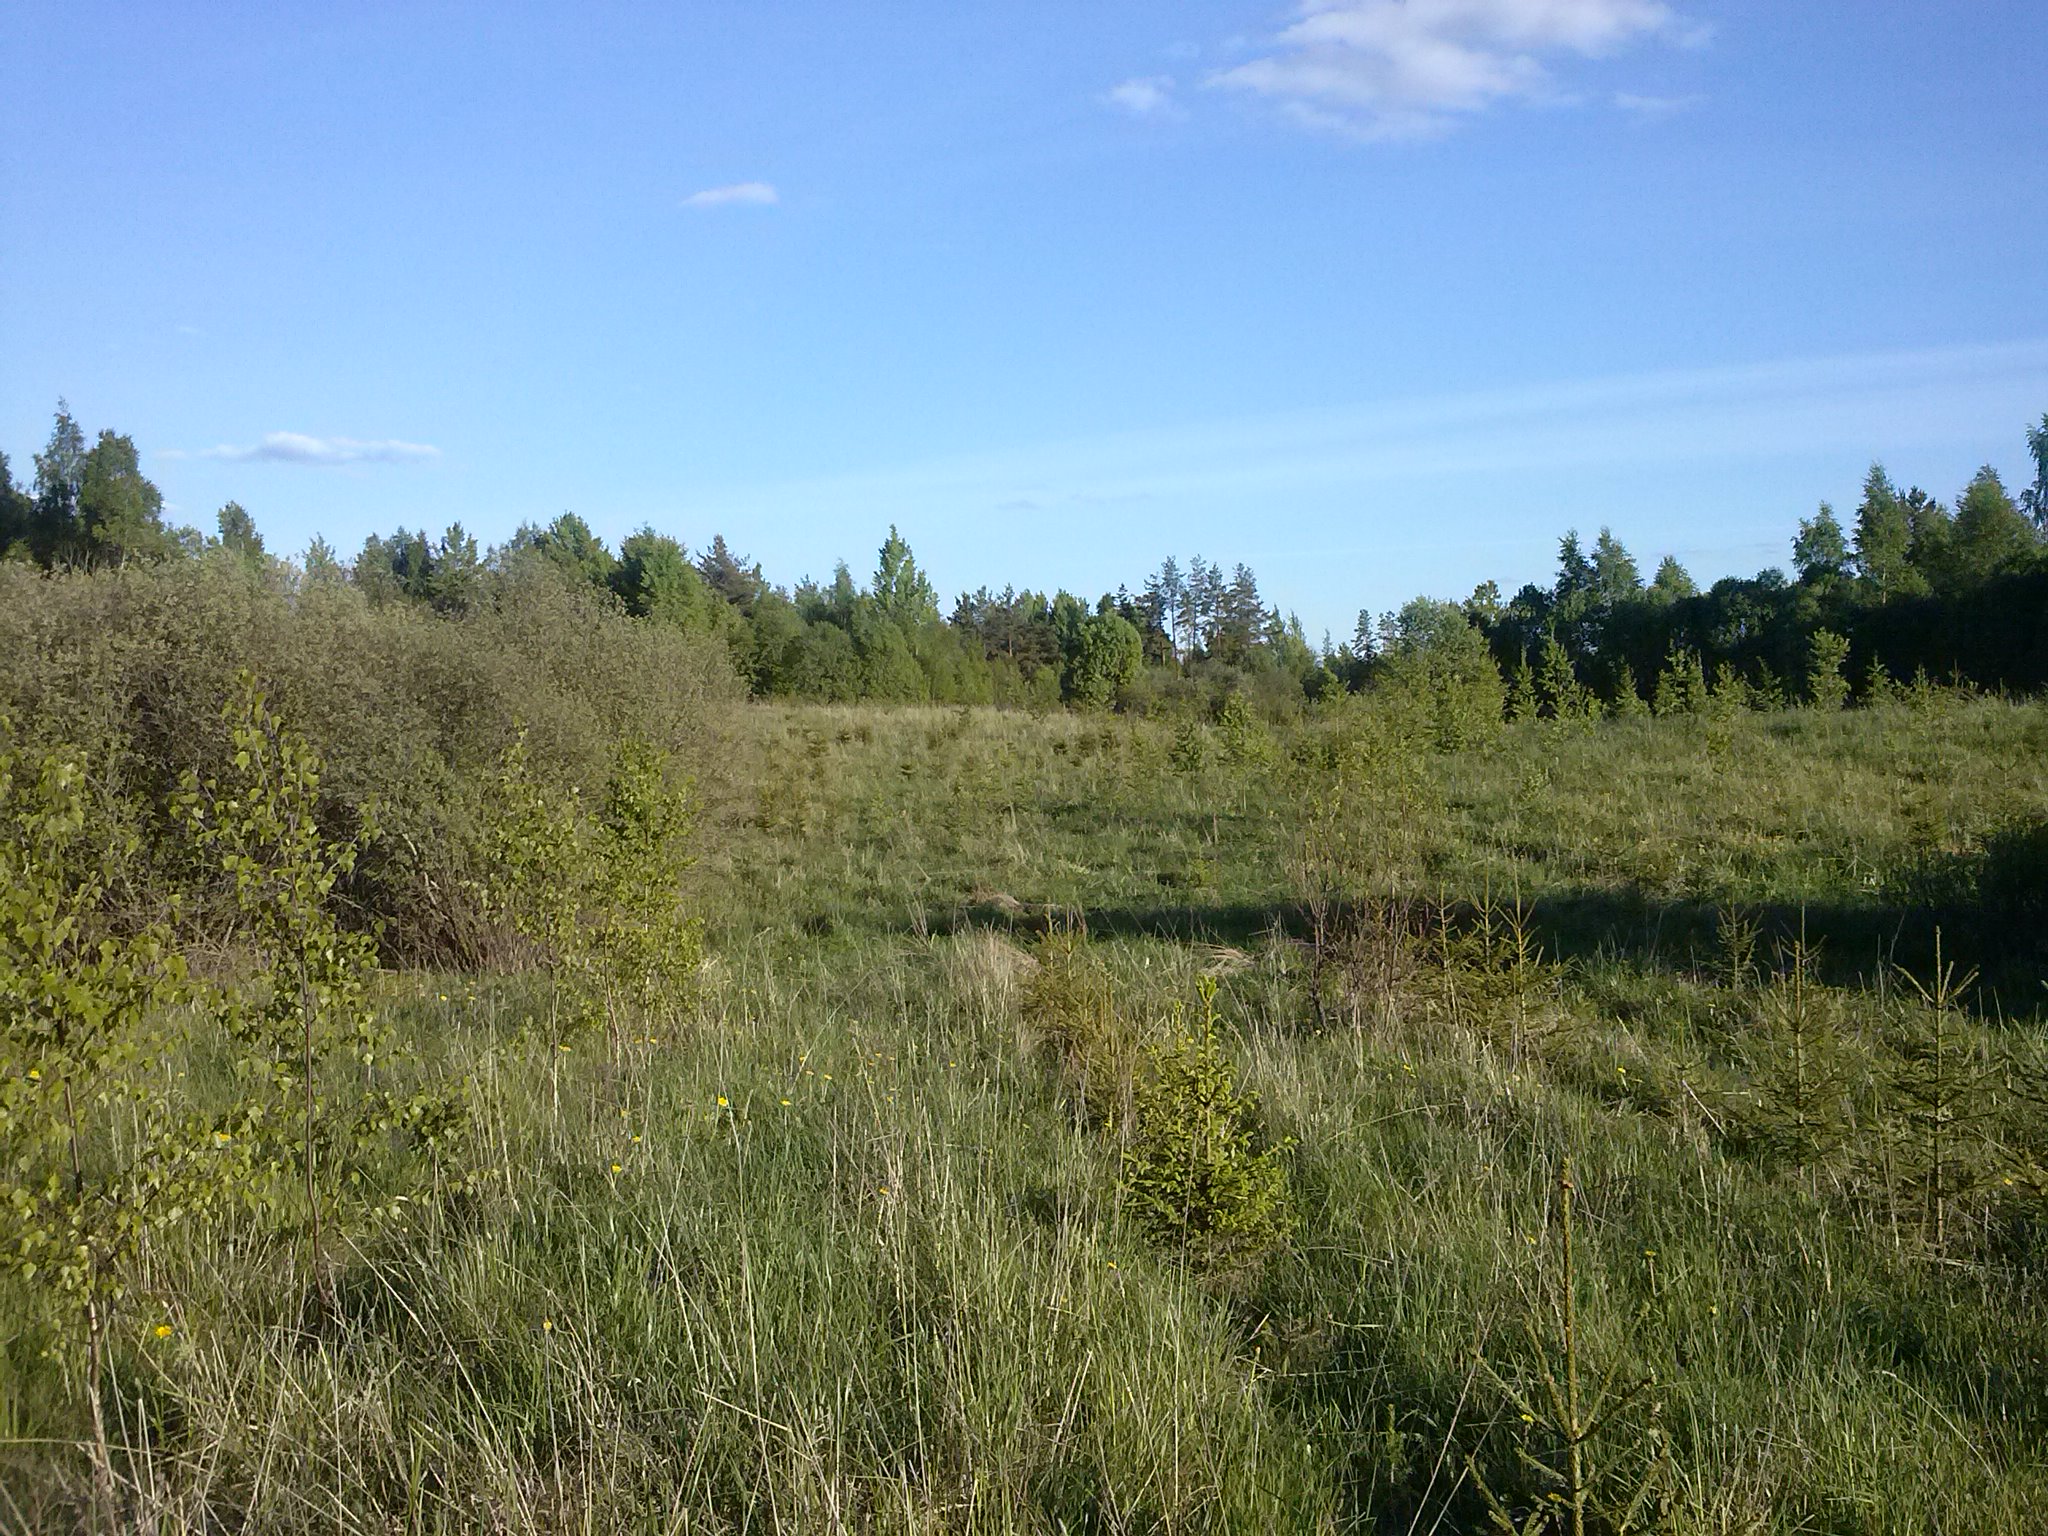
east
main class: Grassland
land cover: Grassland with sparse tree/shrub cover
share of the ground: > 75 %
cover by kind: herbaceous plants 90 %, coniferous forest trees 5 %, shrubs 5 %
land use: Forestry
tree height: < 5 m
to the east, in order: Grassland with sparse tree/shrub cover; Shrubland without tree cover; Grassland with sparse tree/shrub cover; Broadleaved woodland; Grassland with sparse tree/shrub cover; Broadleaved woodland
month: May
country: LV
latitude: 56.1920
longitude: 27.8714
